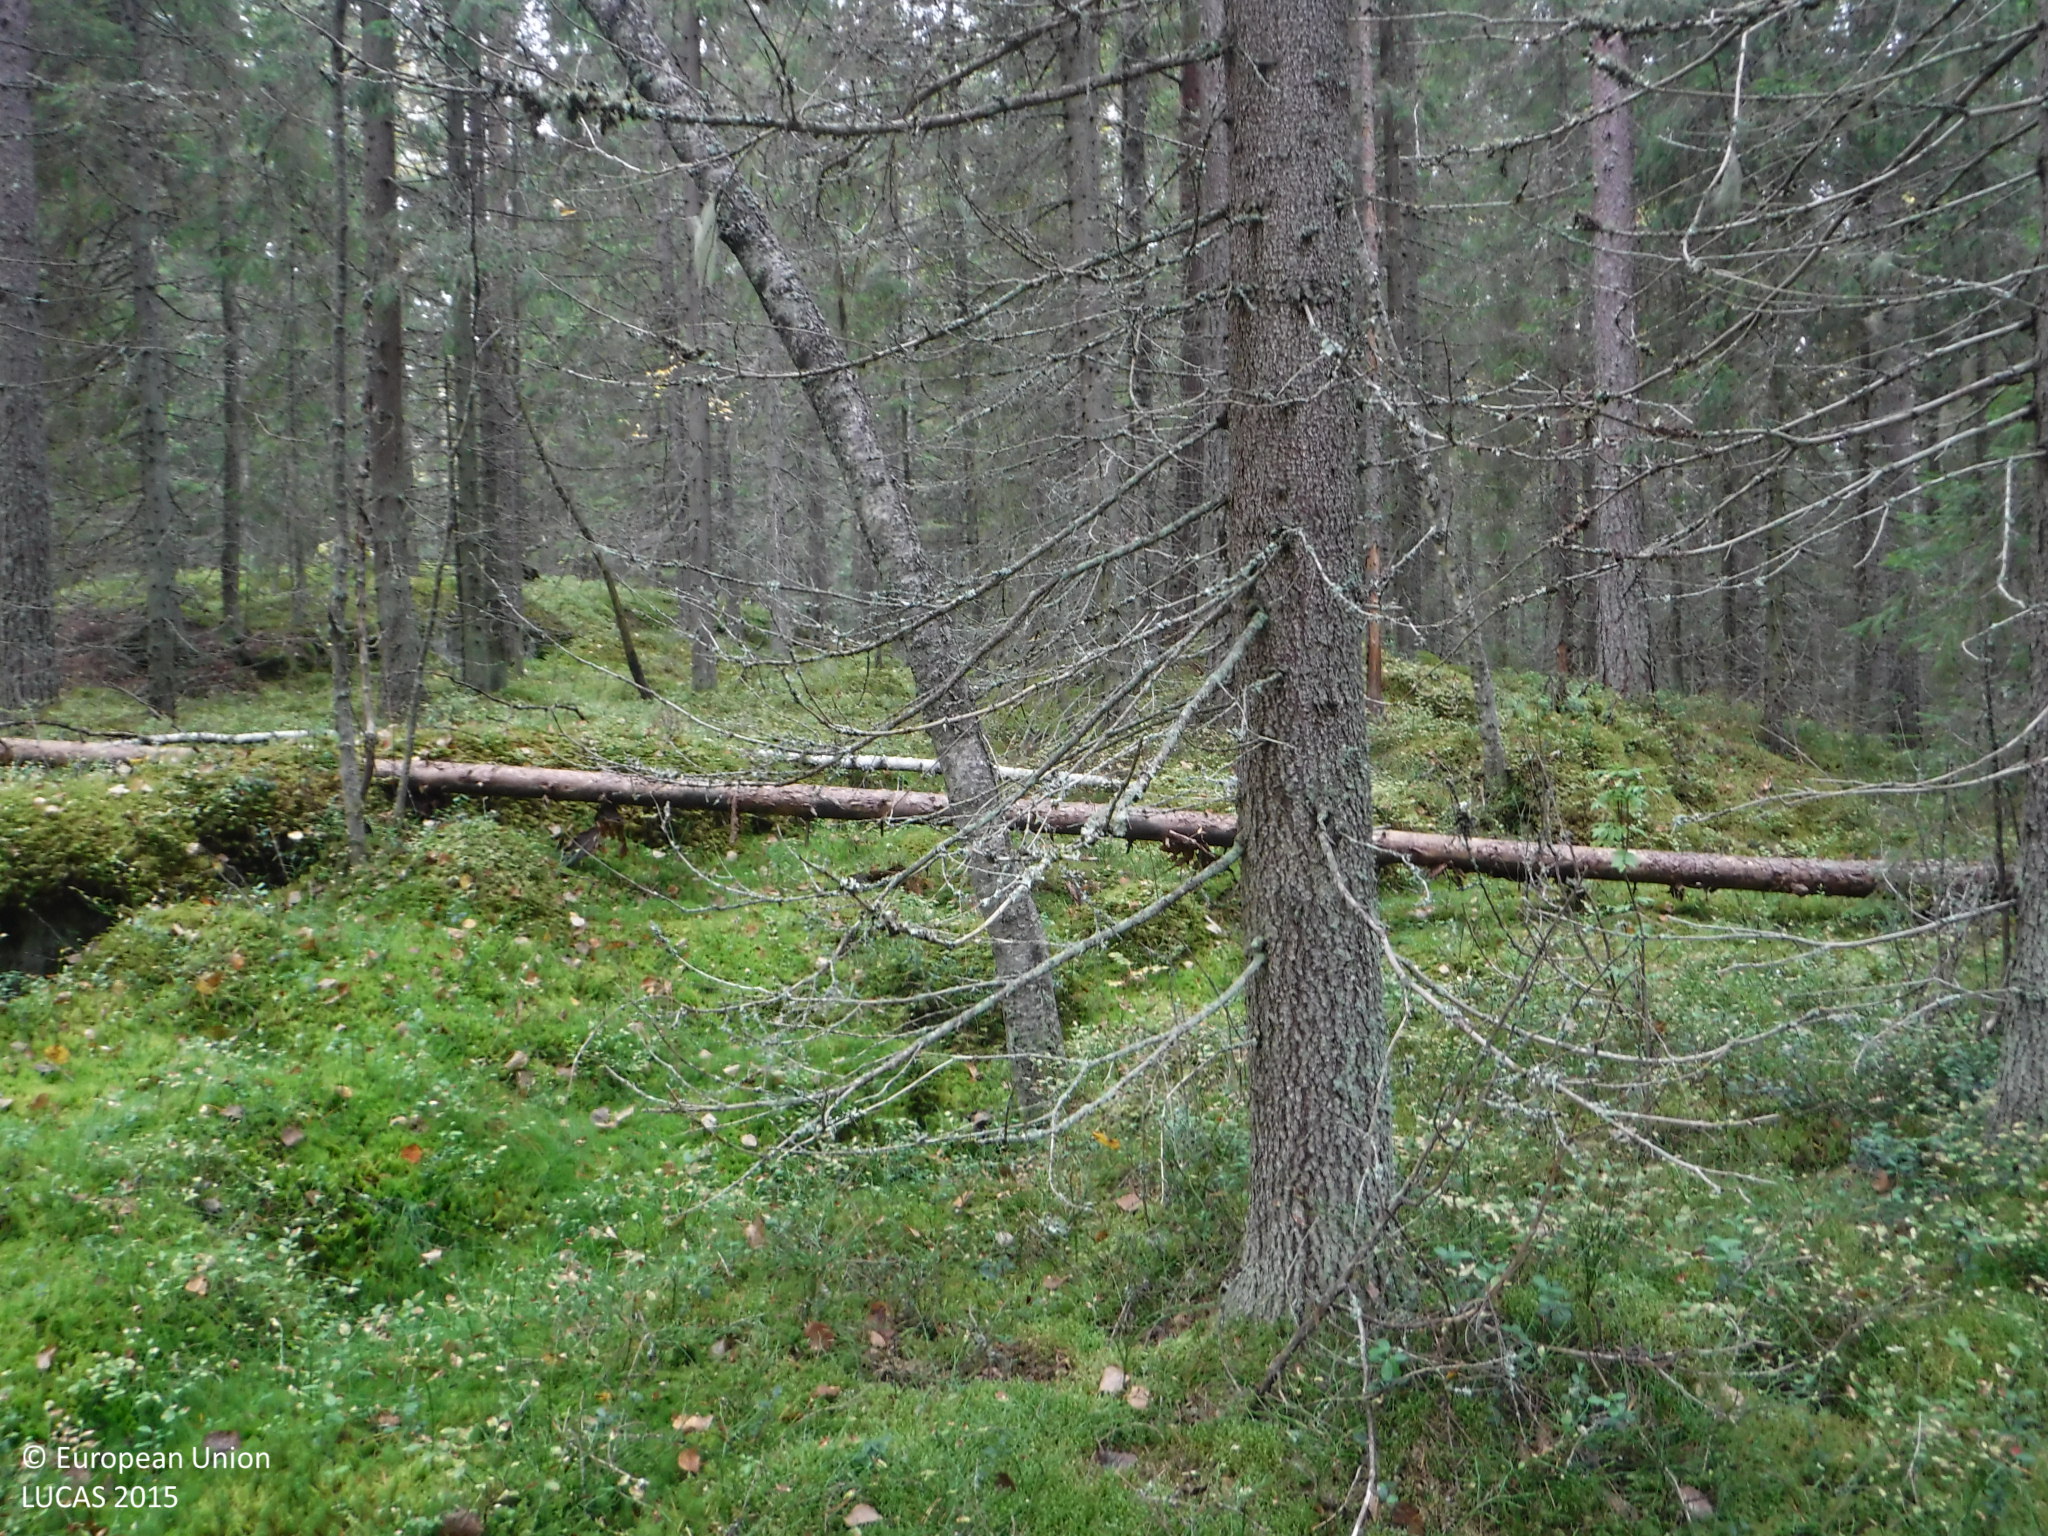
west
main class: Woodland
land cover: Spruce dominated coniferous woodland
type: boreal forest
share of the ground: 50 - 75 %
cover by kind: coniferous forest trees 60 %, lichens and mosses 30 %, shrubs 10 %
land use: Forestry
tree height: > 5 m
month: September
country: FI
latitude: 61.5963
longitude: 23.8992
